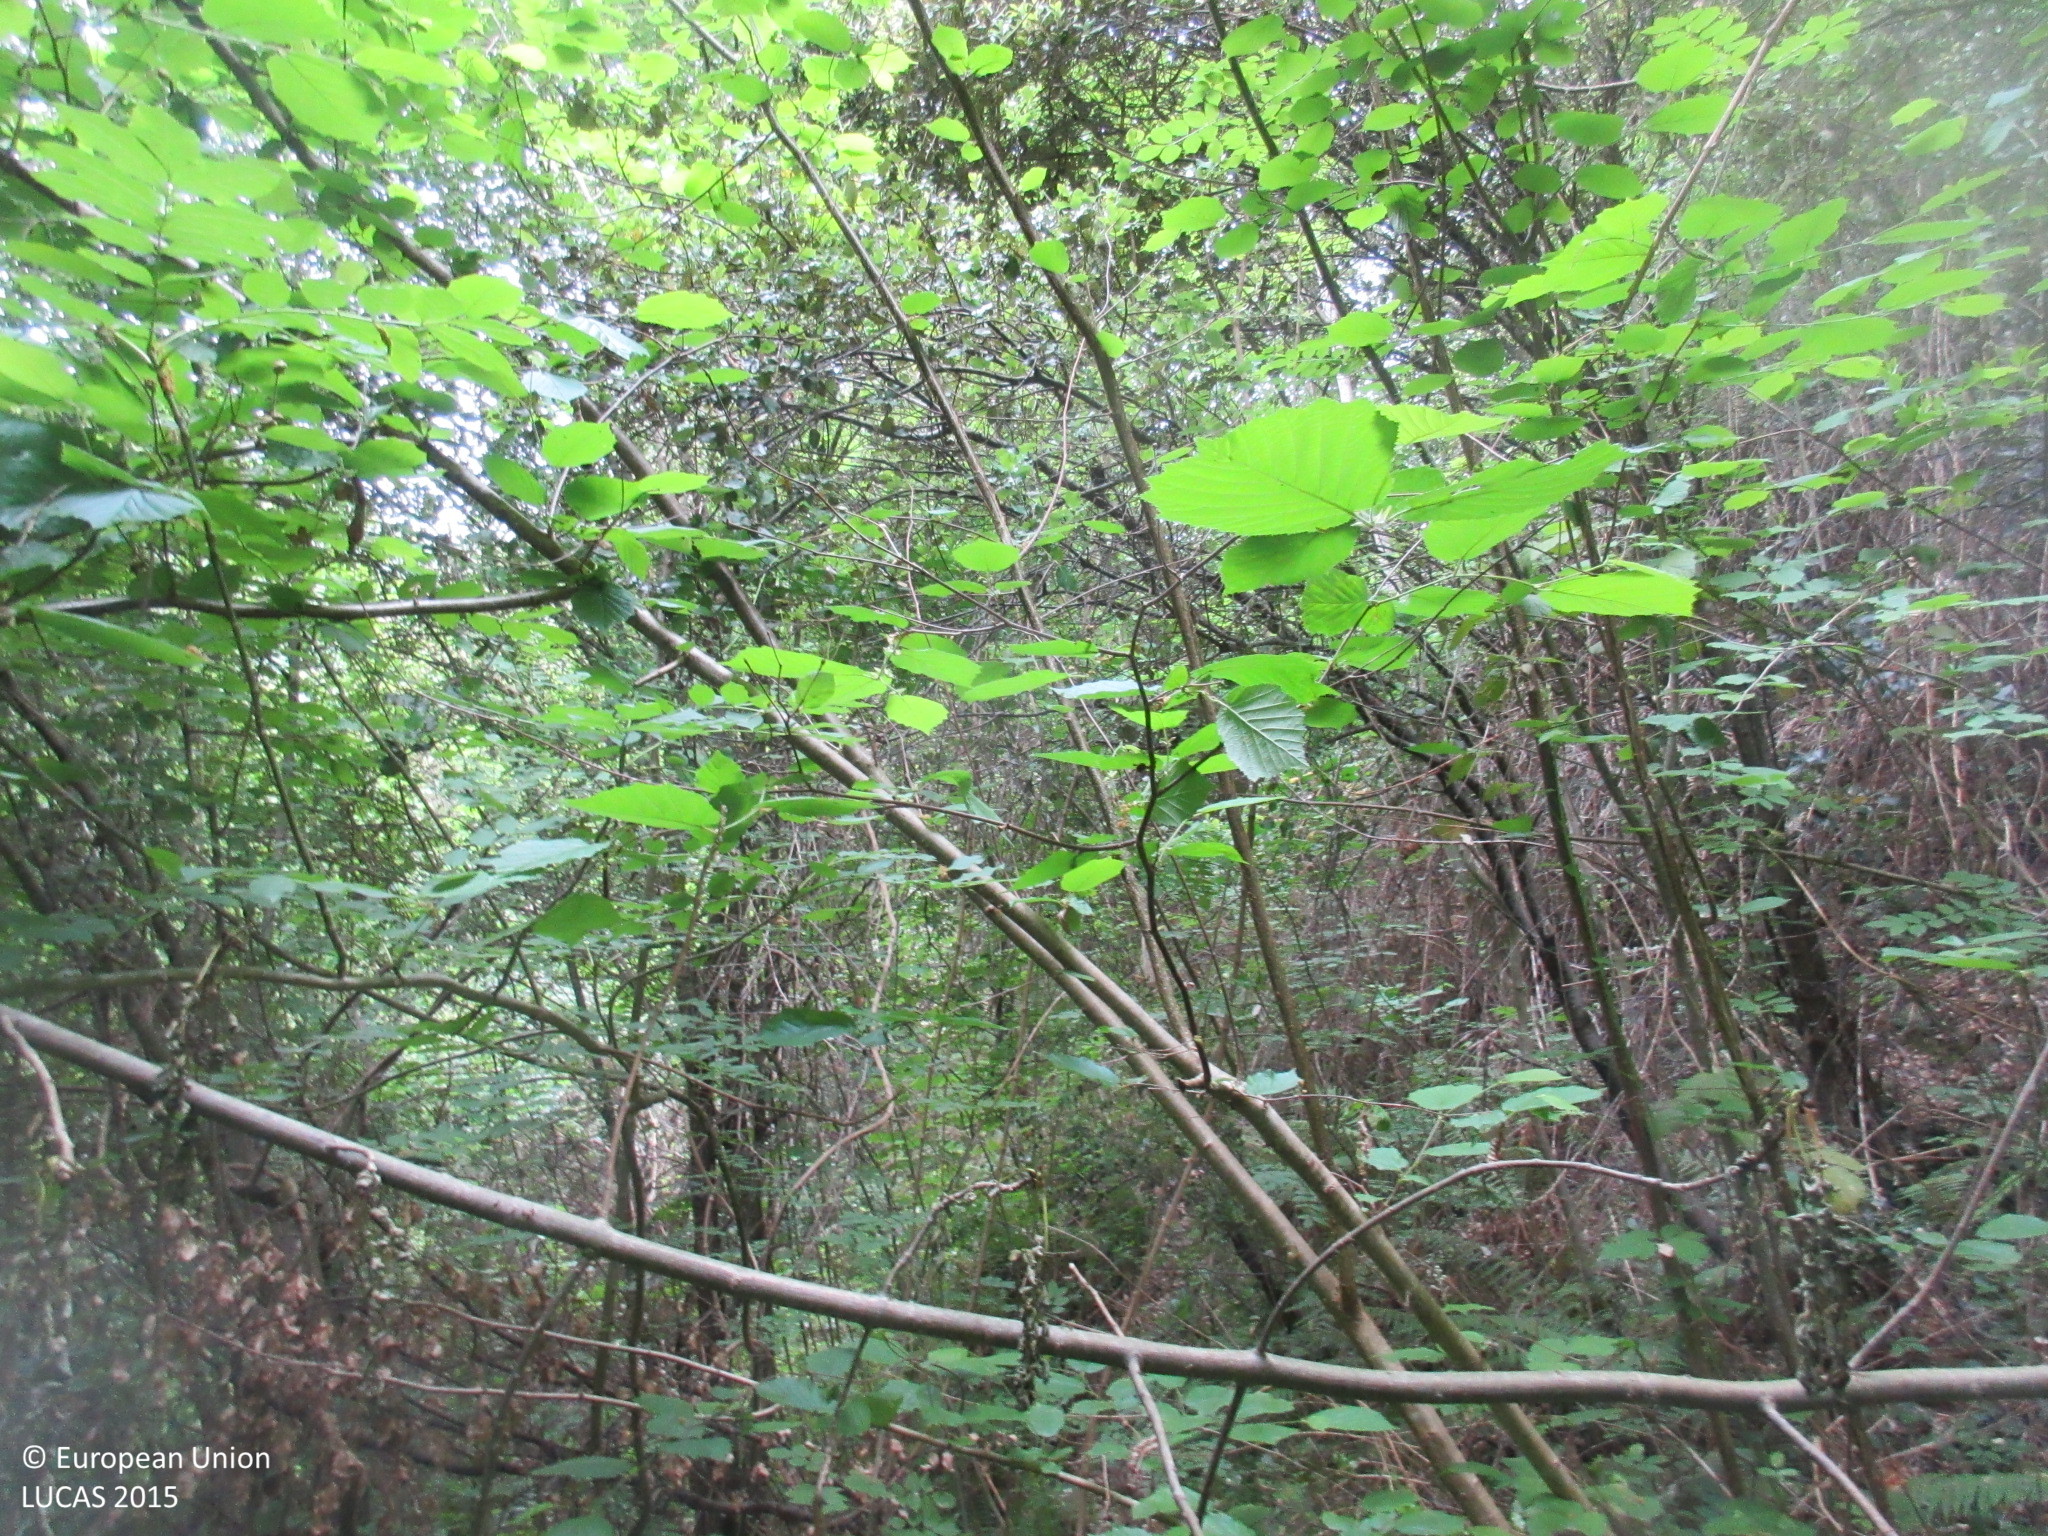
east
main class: Woodland
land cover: Broadleaved woodland
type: thermophilous deciduous forest
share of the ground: > 75 %
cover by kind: broadleaved forest trees 95 %, shrubs 5 %
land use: Semi-natural and natural areas not in use
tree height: > 5 m
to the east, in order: Broadleaved woodland; Grassland with sparse tree/shrub cover; Abandoned hedges; Grassland without tree/shrub cover; Fences; Tracks; Artificial constructions in urban areas; Electric lines; Grassland without tree/shrub cover
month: June
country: ES
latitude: 43.1316
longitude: -4.5773
